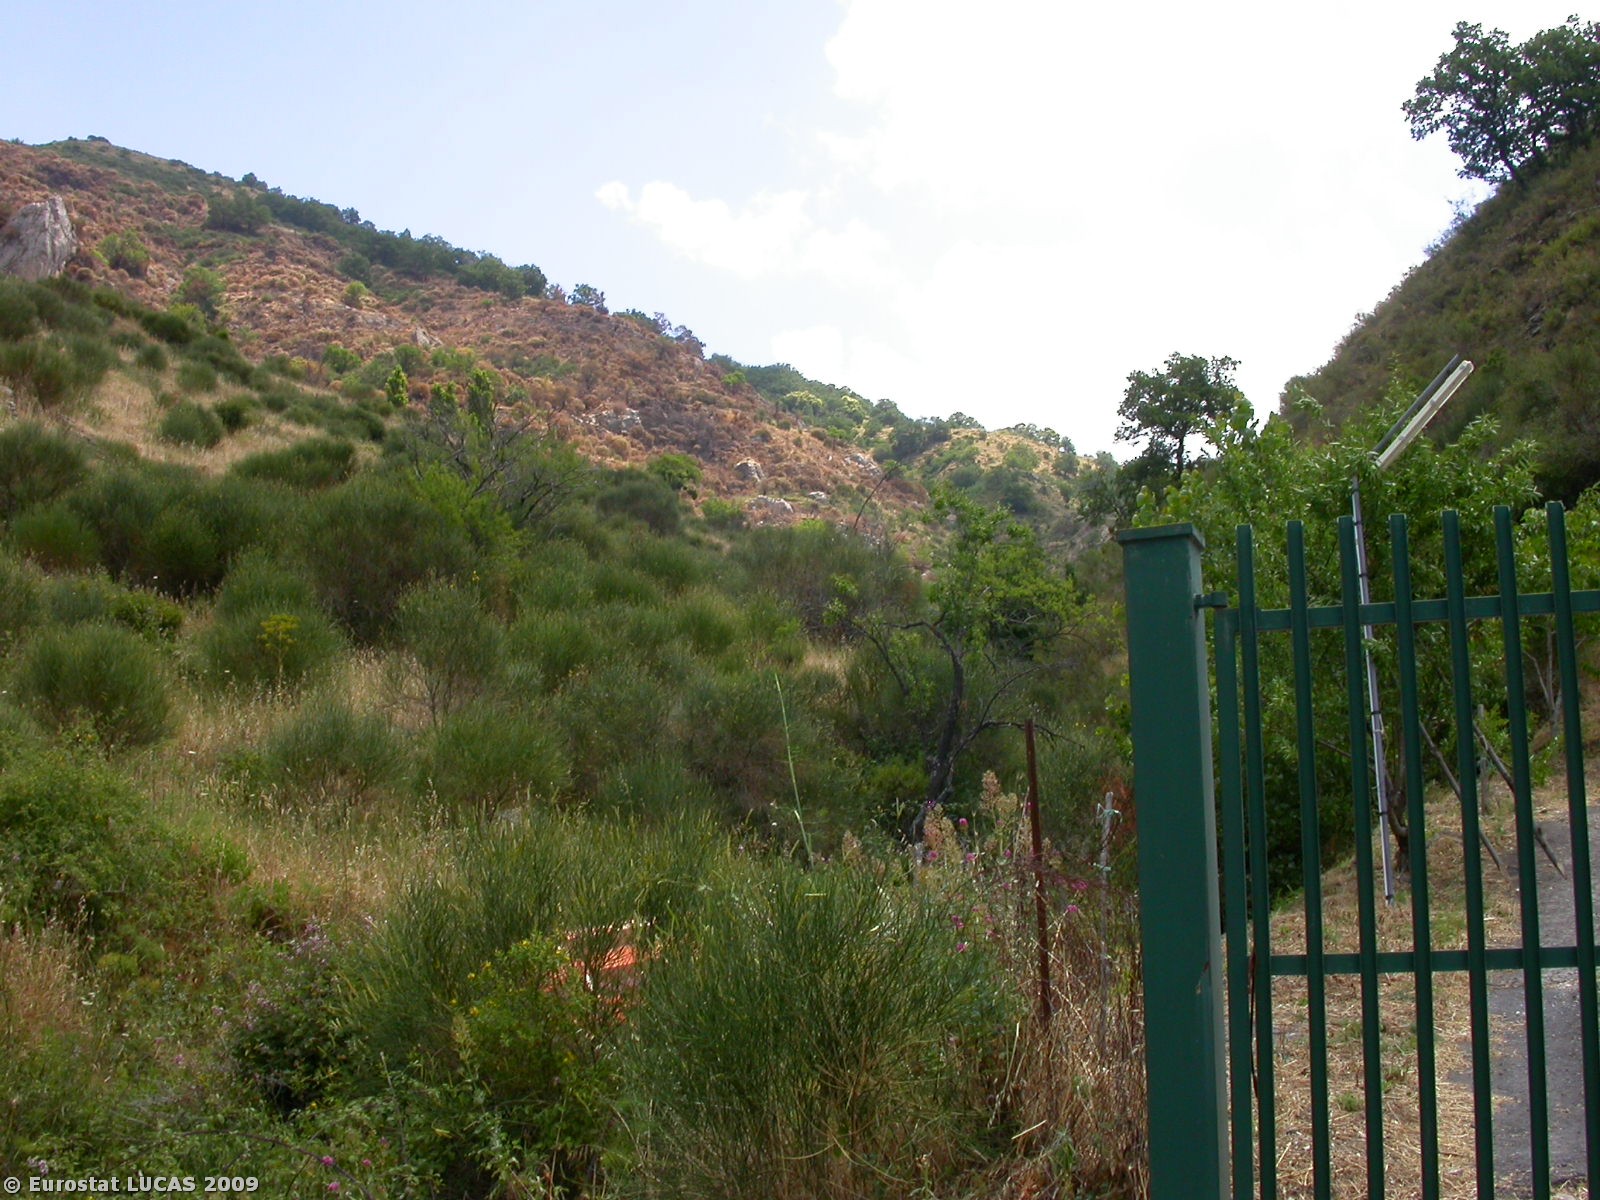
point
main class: Shrubland
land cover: Shrubland with sparse tree cover
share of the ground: > 75 %
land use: Agriculture (excluding fallow land and kitchen gardens)
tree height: > 5 m
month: July
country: IT
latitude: 37.9428
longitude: 15.0073
